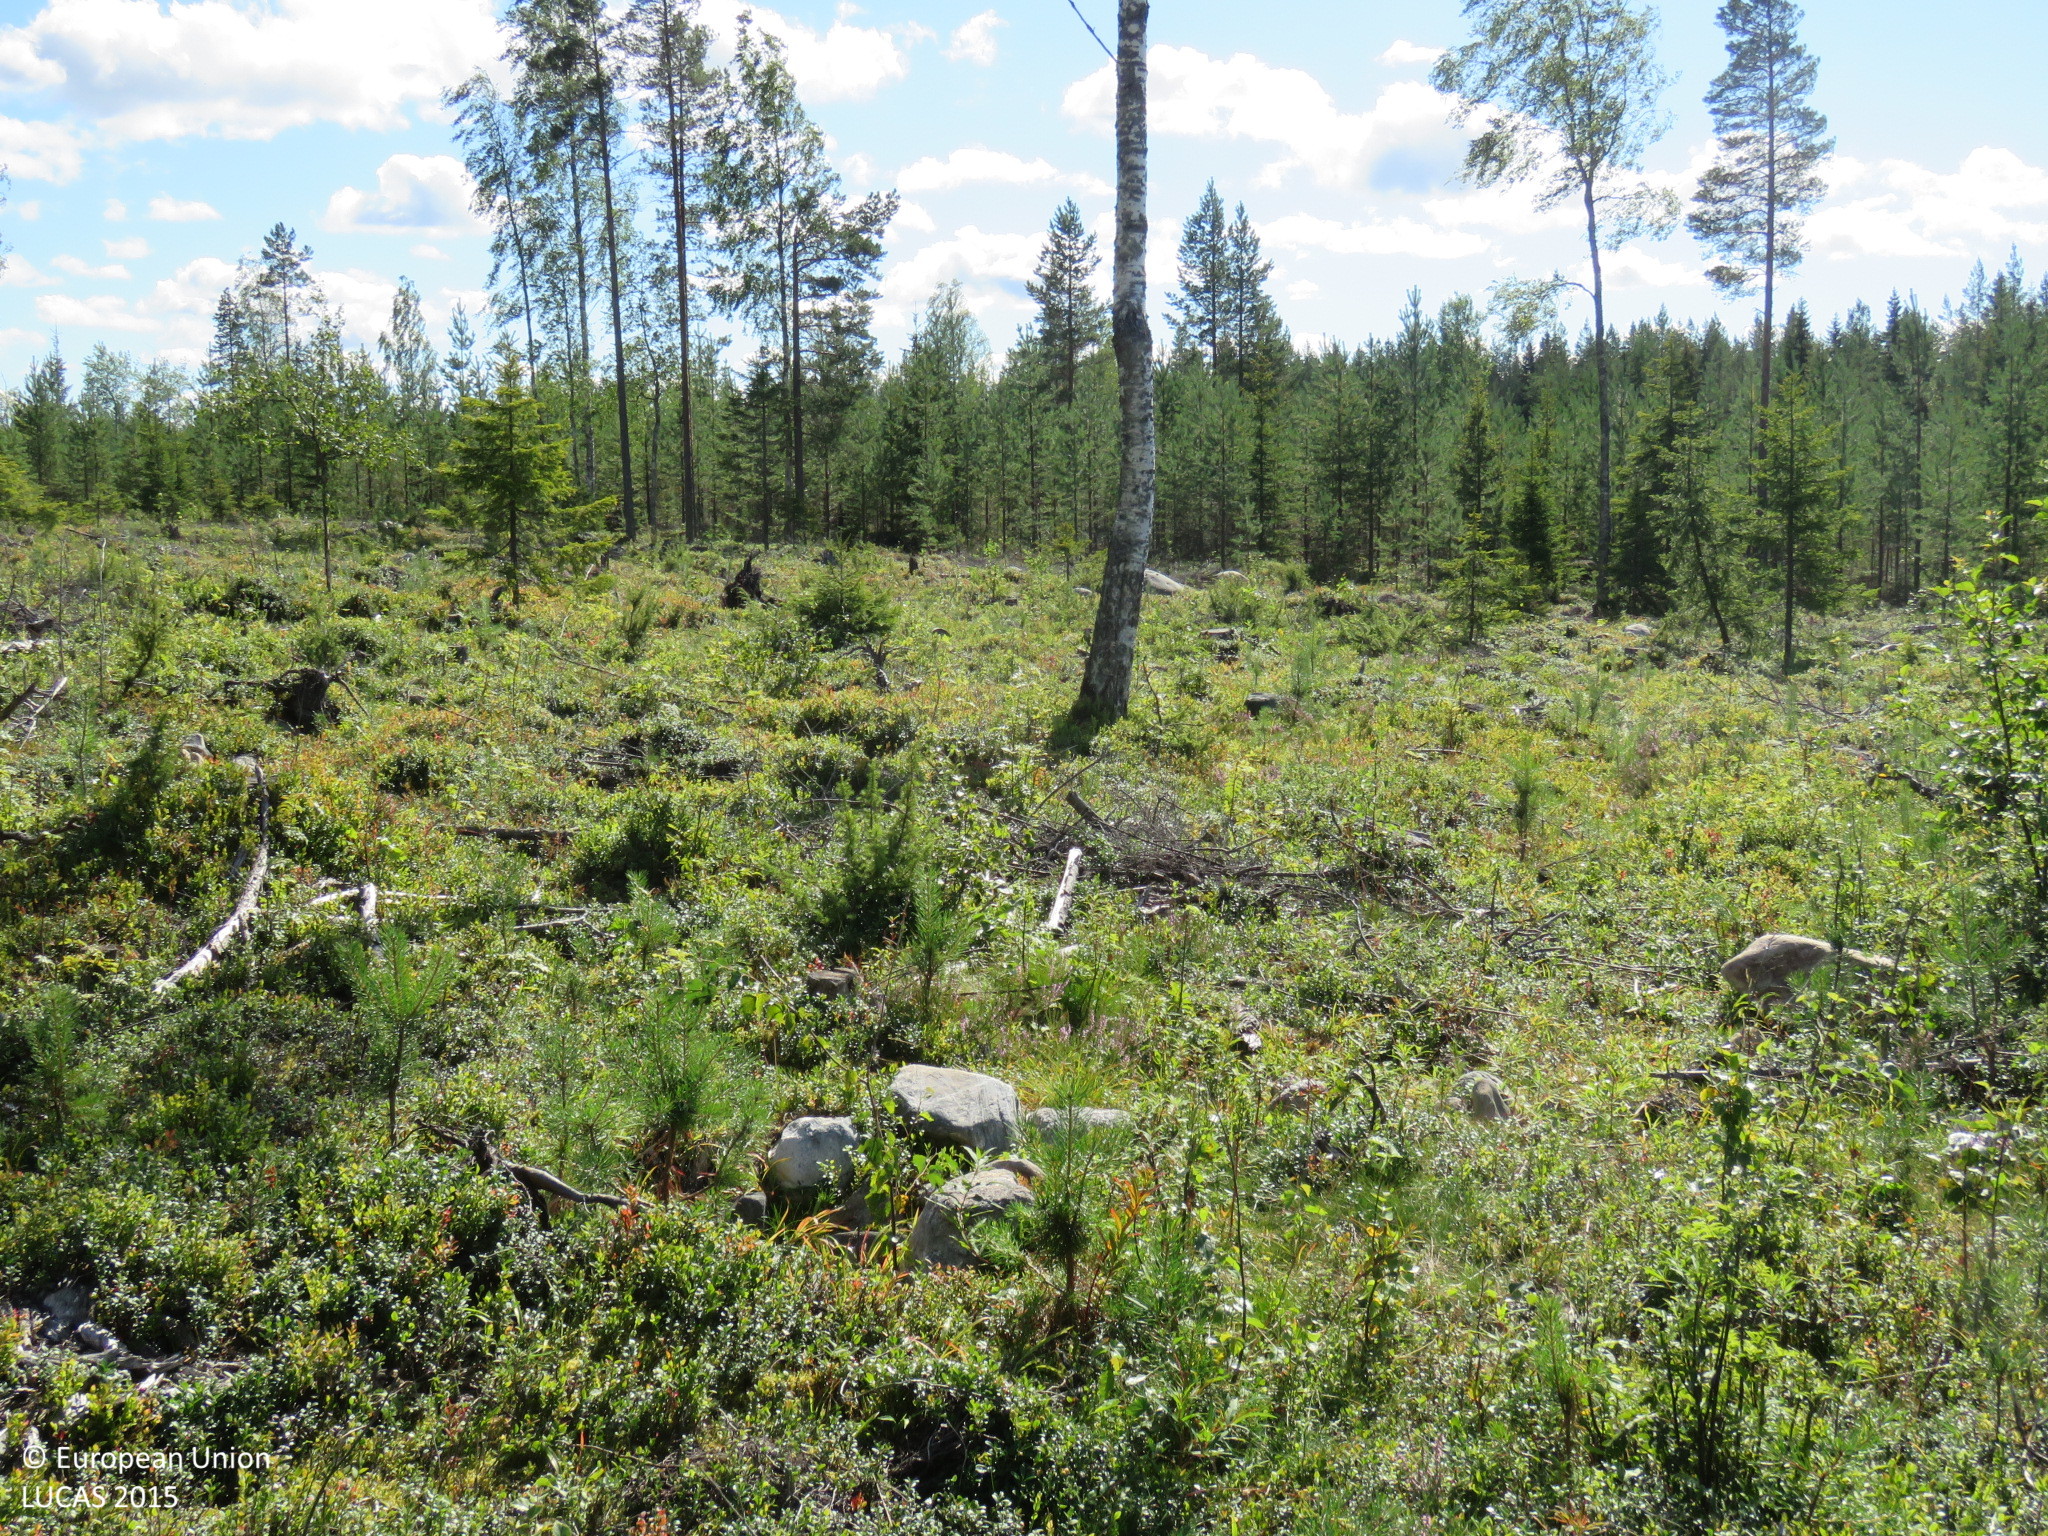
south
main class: Woodland
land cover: Other mixed woodland
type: boreal forest
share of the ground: 25 - 50 %
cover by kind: shrubs 40 %, coniferous forest trees 20 %, herbaceous plants 20 %, broadleaved forest trees 10 %, unconsolidated bare surface 10 %
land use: Forestry
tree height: < 5 m
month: August
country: FI
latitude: 65.2245
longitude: 26.0259
